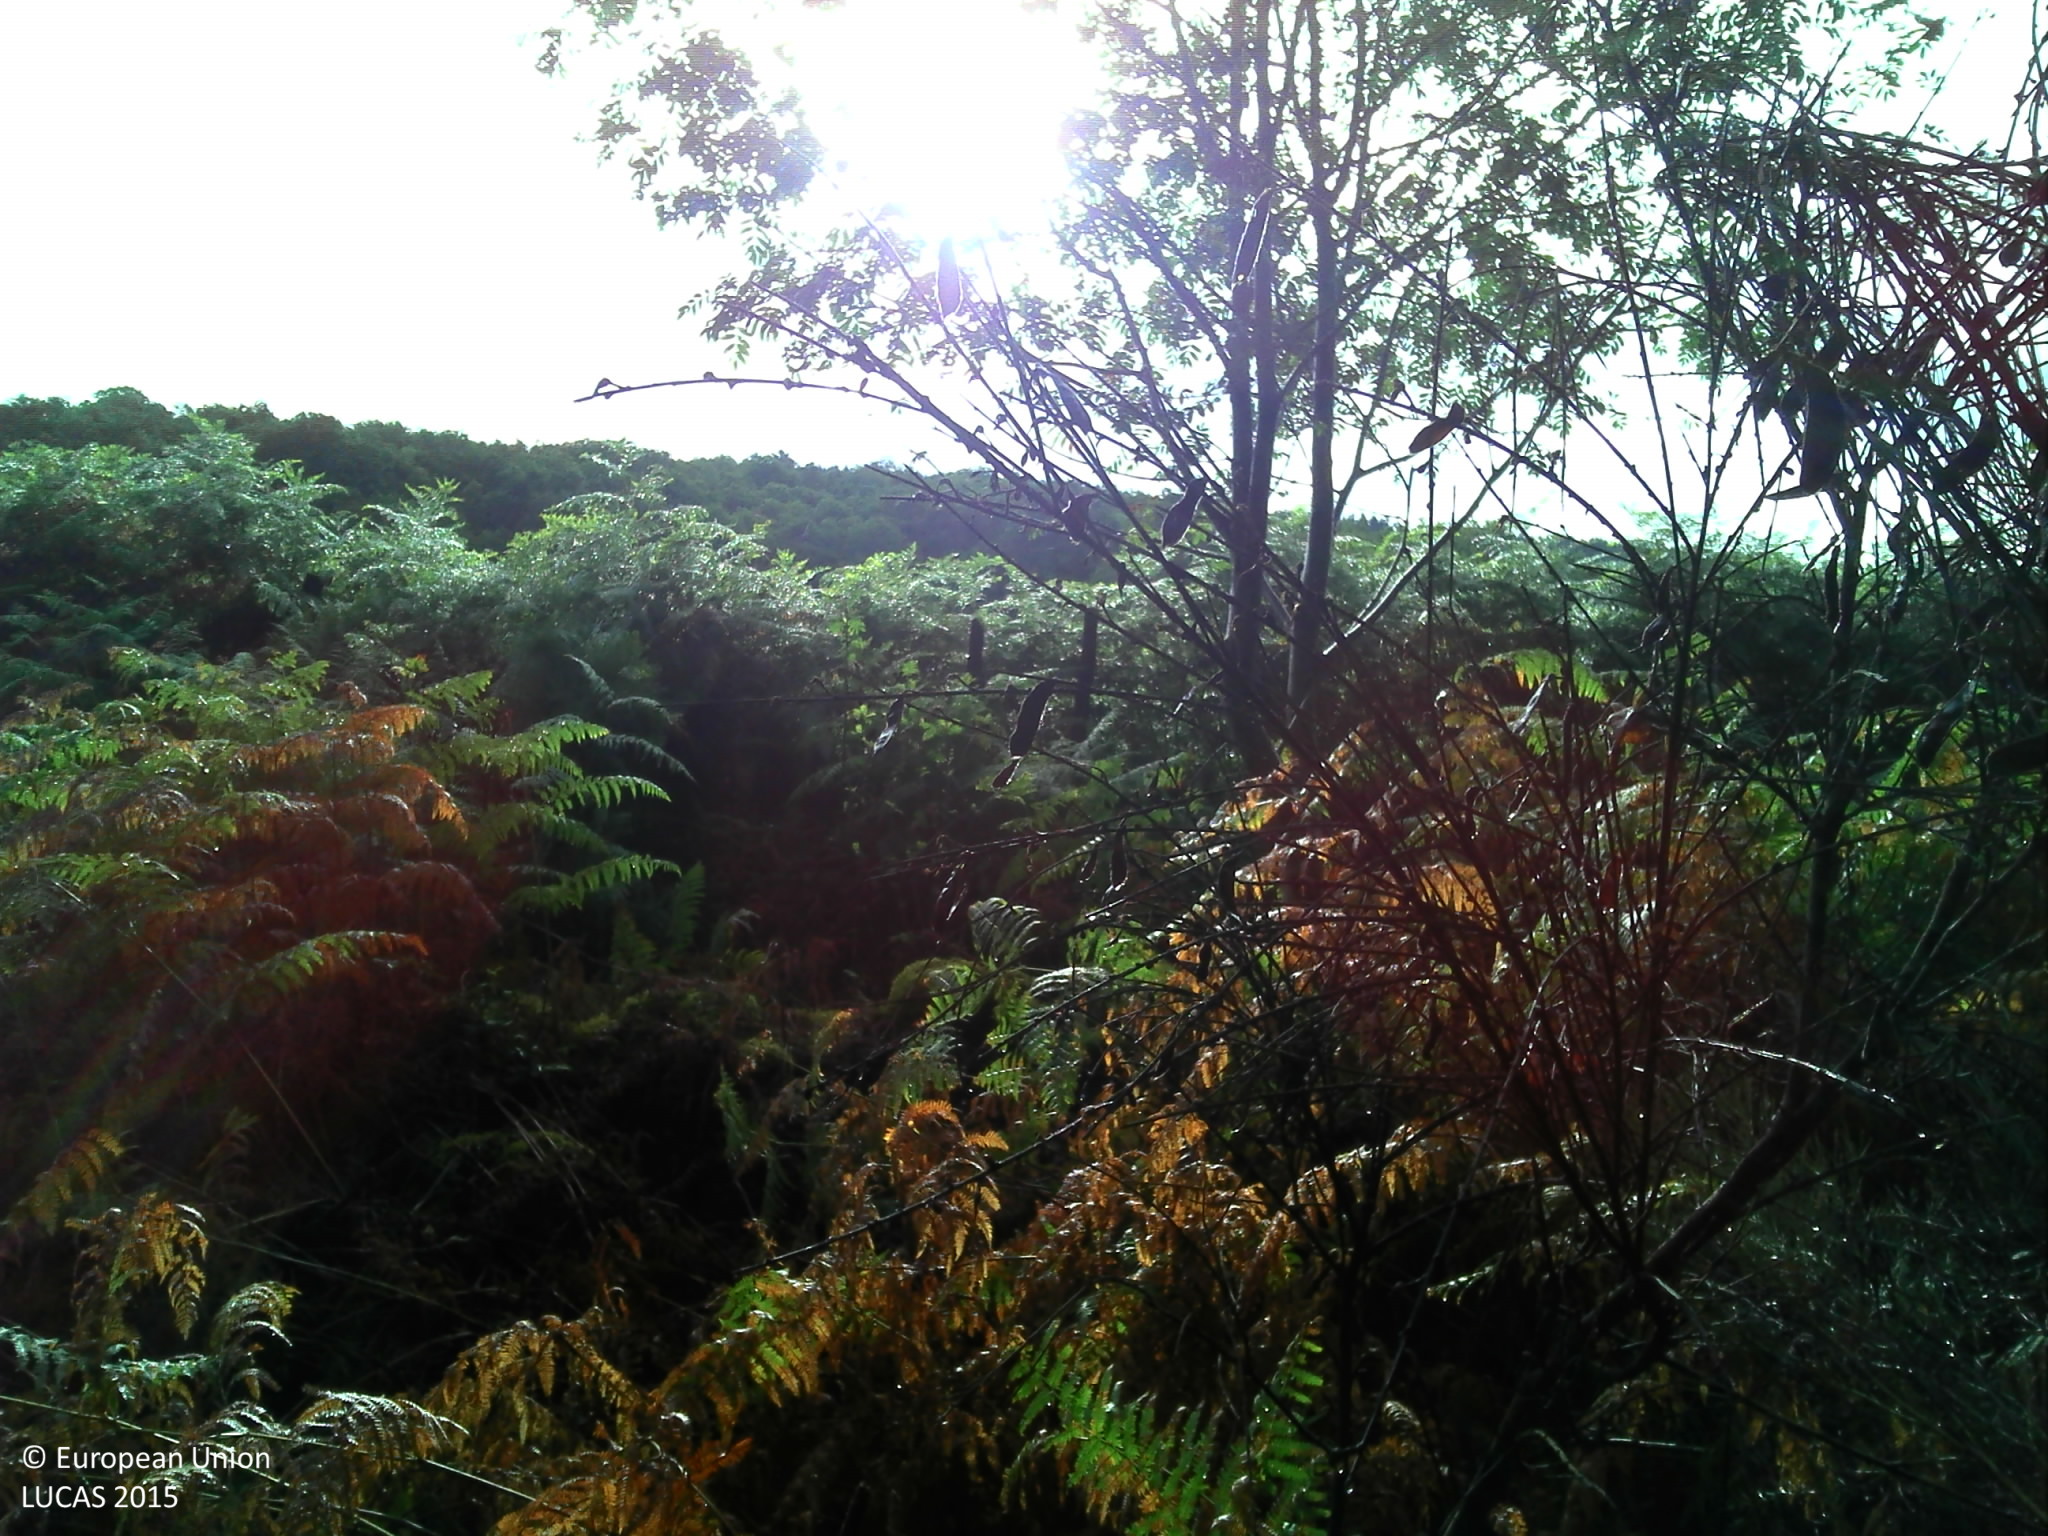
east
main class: Woodland
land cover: Broadleaved woodland
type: thermophilous deciduous forest
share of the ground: 50 - 75 %
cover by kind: herbaceous plants 70 %, broadleaved forest trees 30 %
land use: Forestry
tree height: > 5 m
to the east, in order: Broadleaved woodland; Spontaneously vegetated surfaces; Ditches and canals; Fences; Abandoned hedges; Grassland without tree/shrub cover; Lines of trees; Spontaneously vegetated surfaces; Fences; Broadleaved woodland
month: August
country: FR
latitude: 45.5102
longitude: 1.7904
